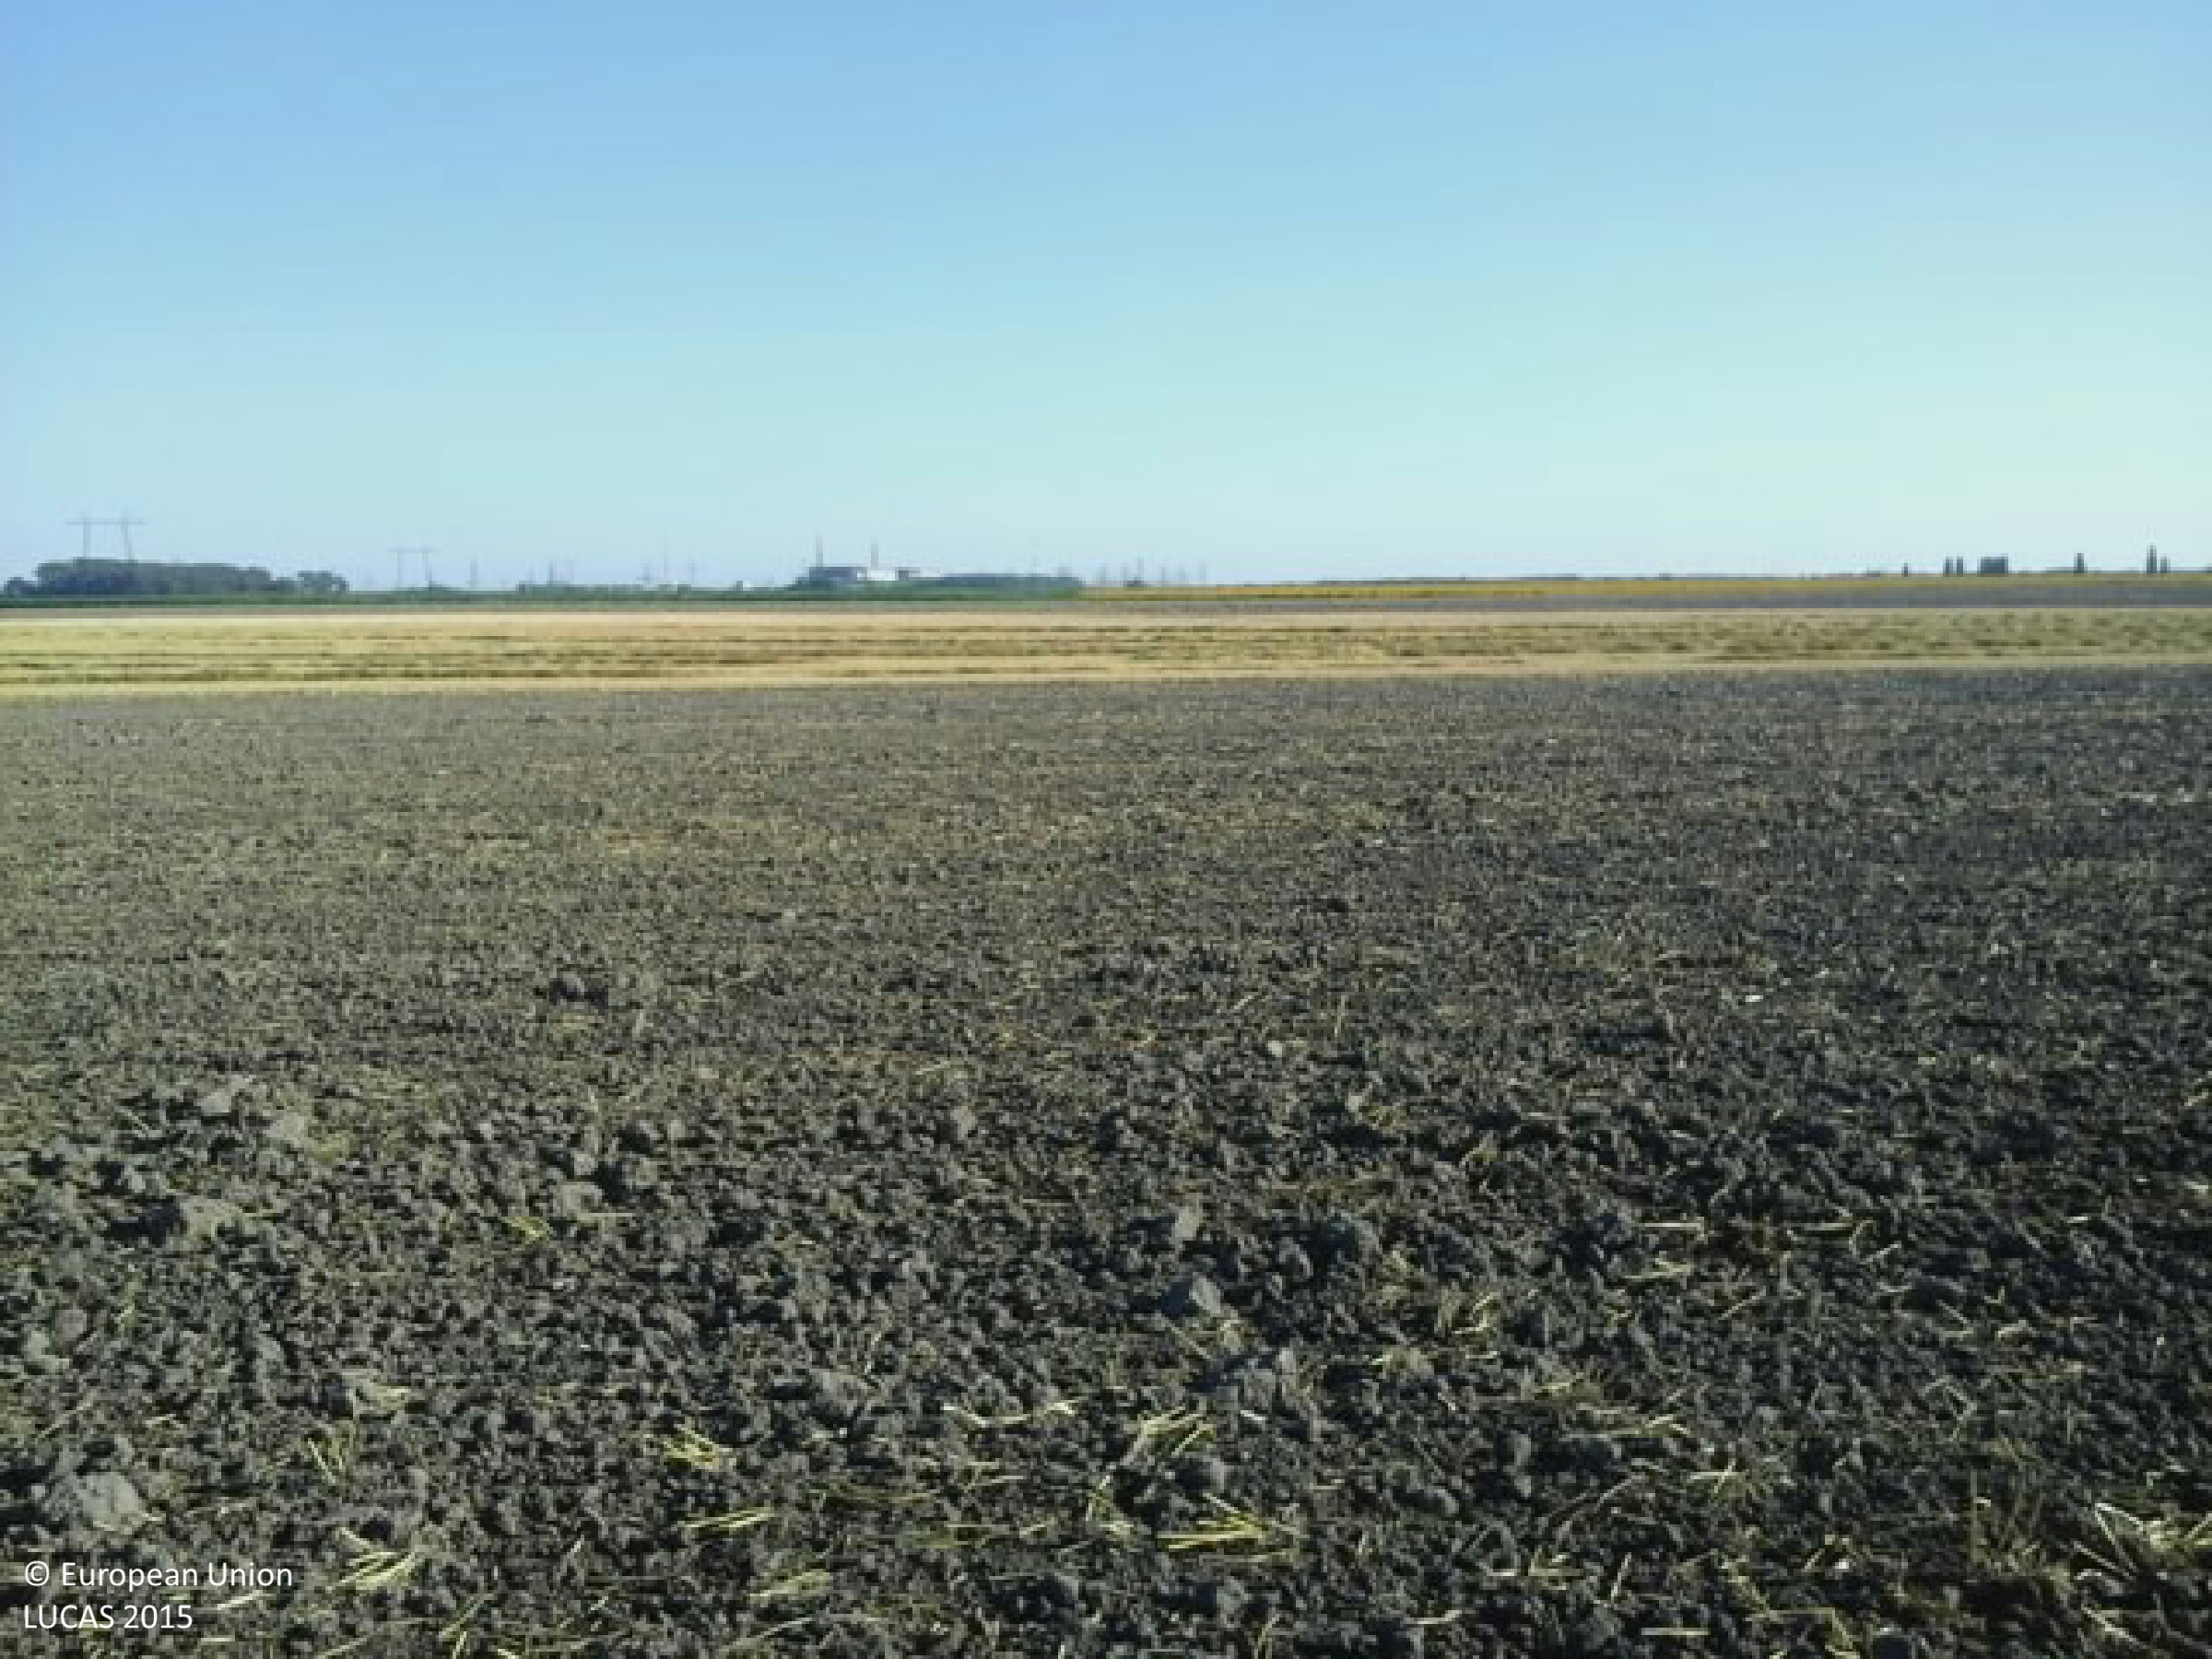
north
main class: Cropland
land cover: Common wheat
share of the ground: < 10 %
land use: Agriculture (excluding fallow land and kitchen gardens)
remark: Harvested field
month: July
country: HU
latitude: 46.5438
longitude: 18.8675
